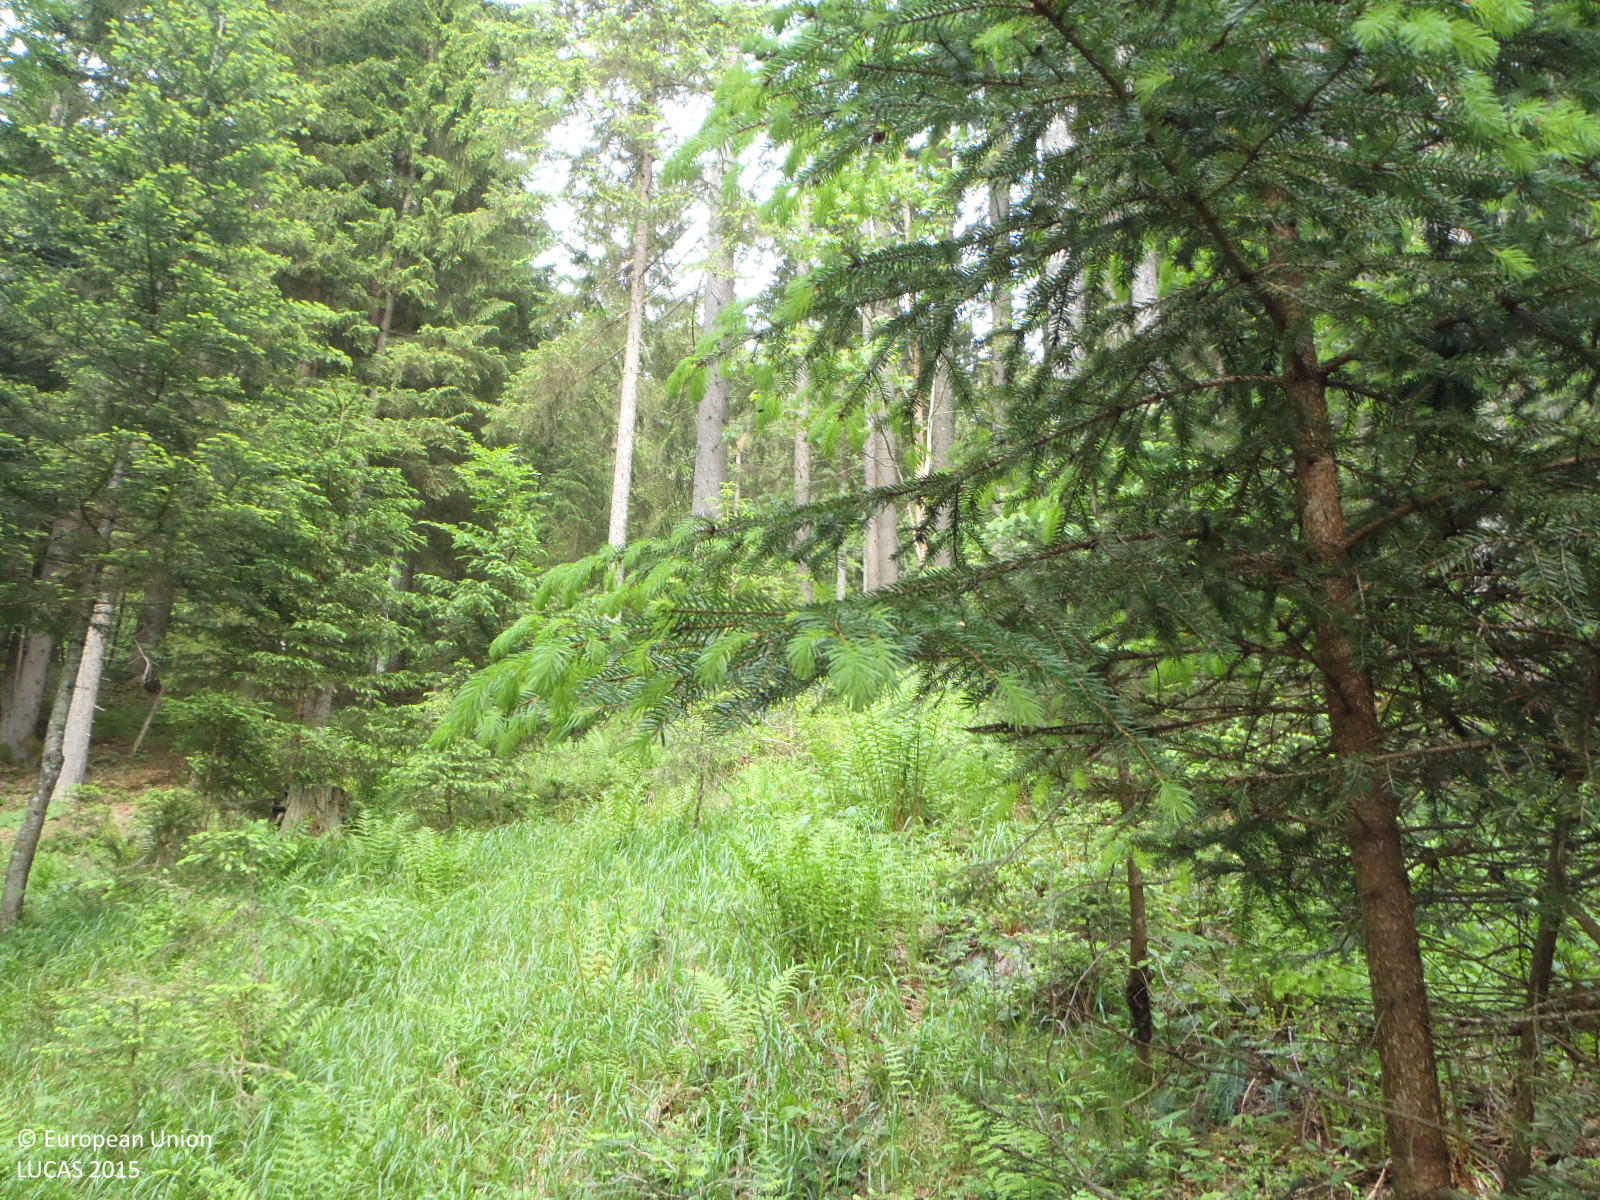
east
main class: Woodland
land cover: Spruce dominated coniferous woodland
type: alpine coniferous forest
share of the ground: > 75 %
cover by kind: coniferous forest trees 60 %, herbaceous plants 20 %, broadleaved forest trees 15 %, shrubs 5 %
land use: Forestry
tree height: > 5 m
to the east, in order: Spruce dominated coniferous woodland; Other mixed woodland; Other coniferous woodland; Tracks; Other coniferous woodland
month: June
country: AT
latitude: 47.5108
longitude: 12.5079
